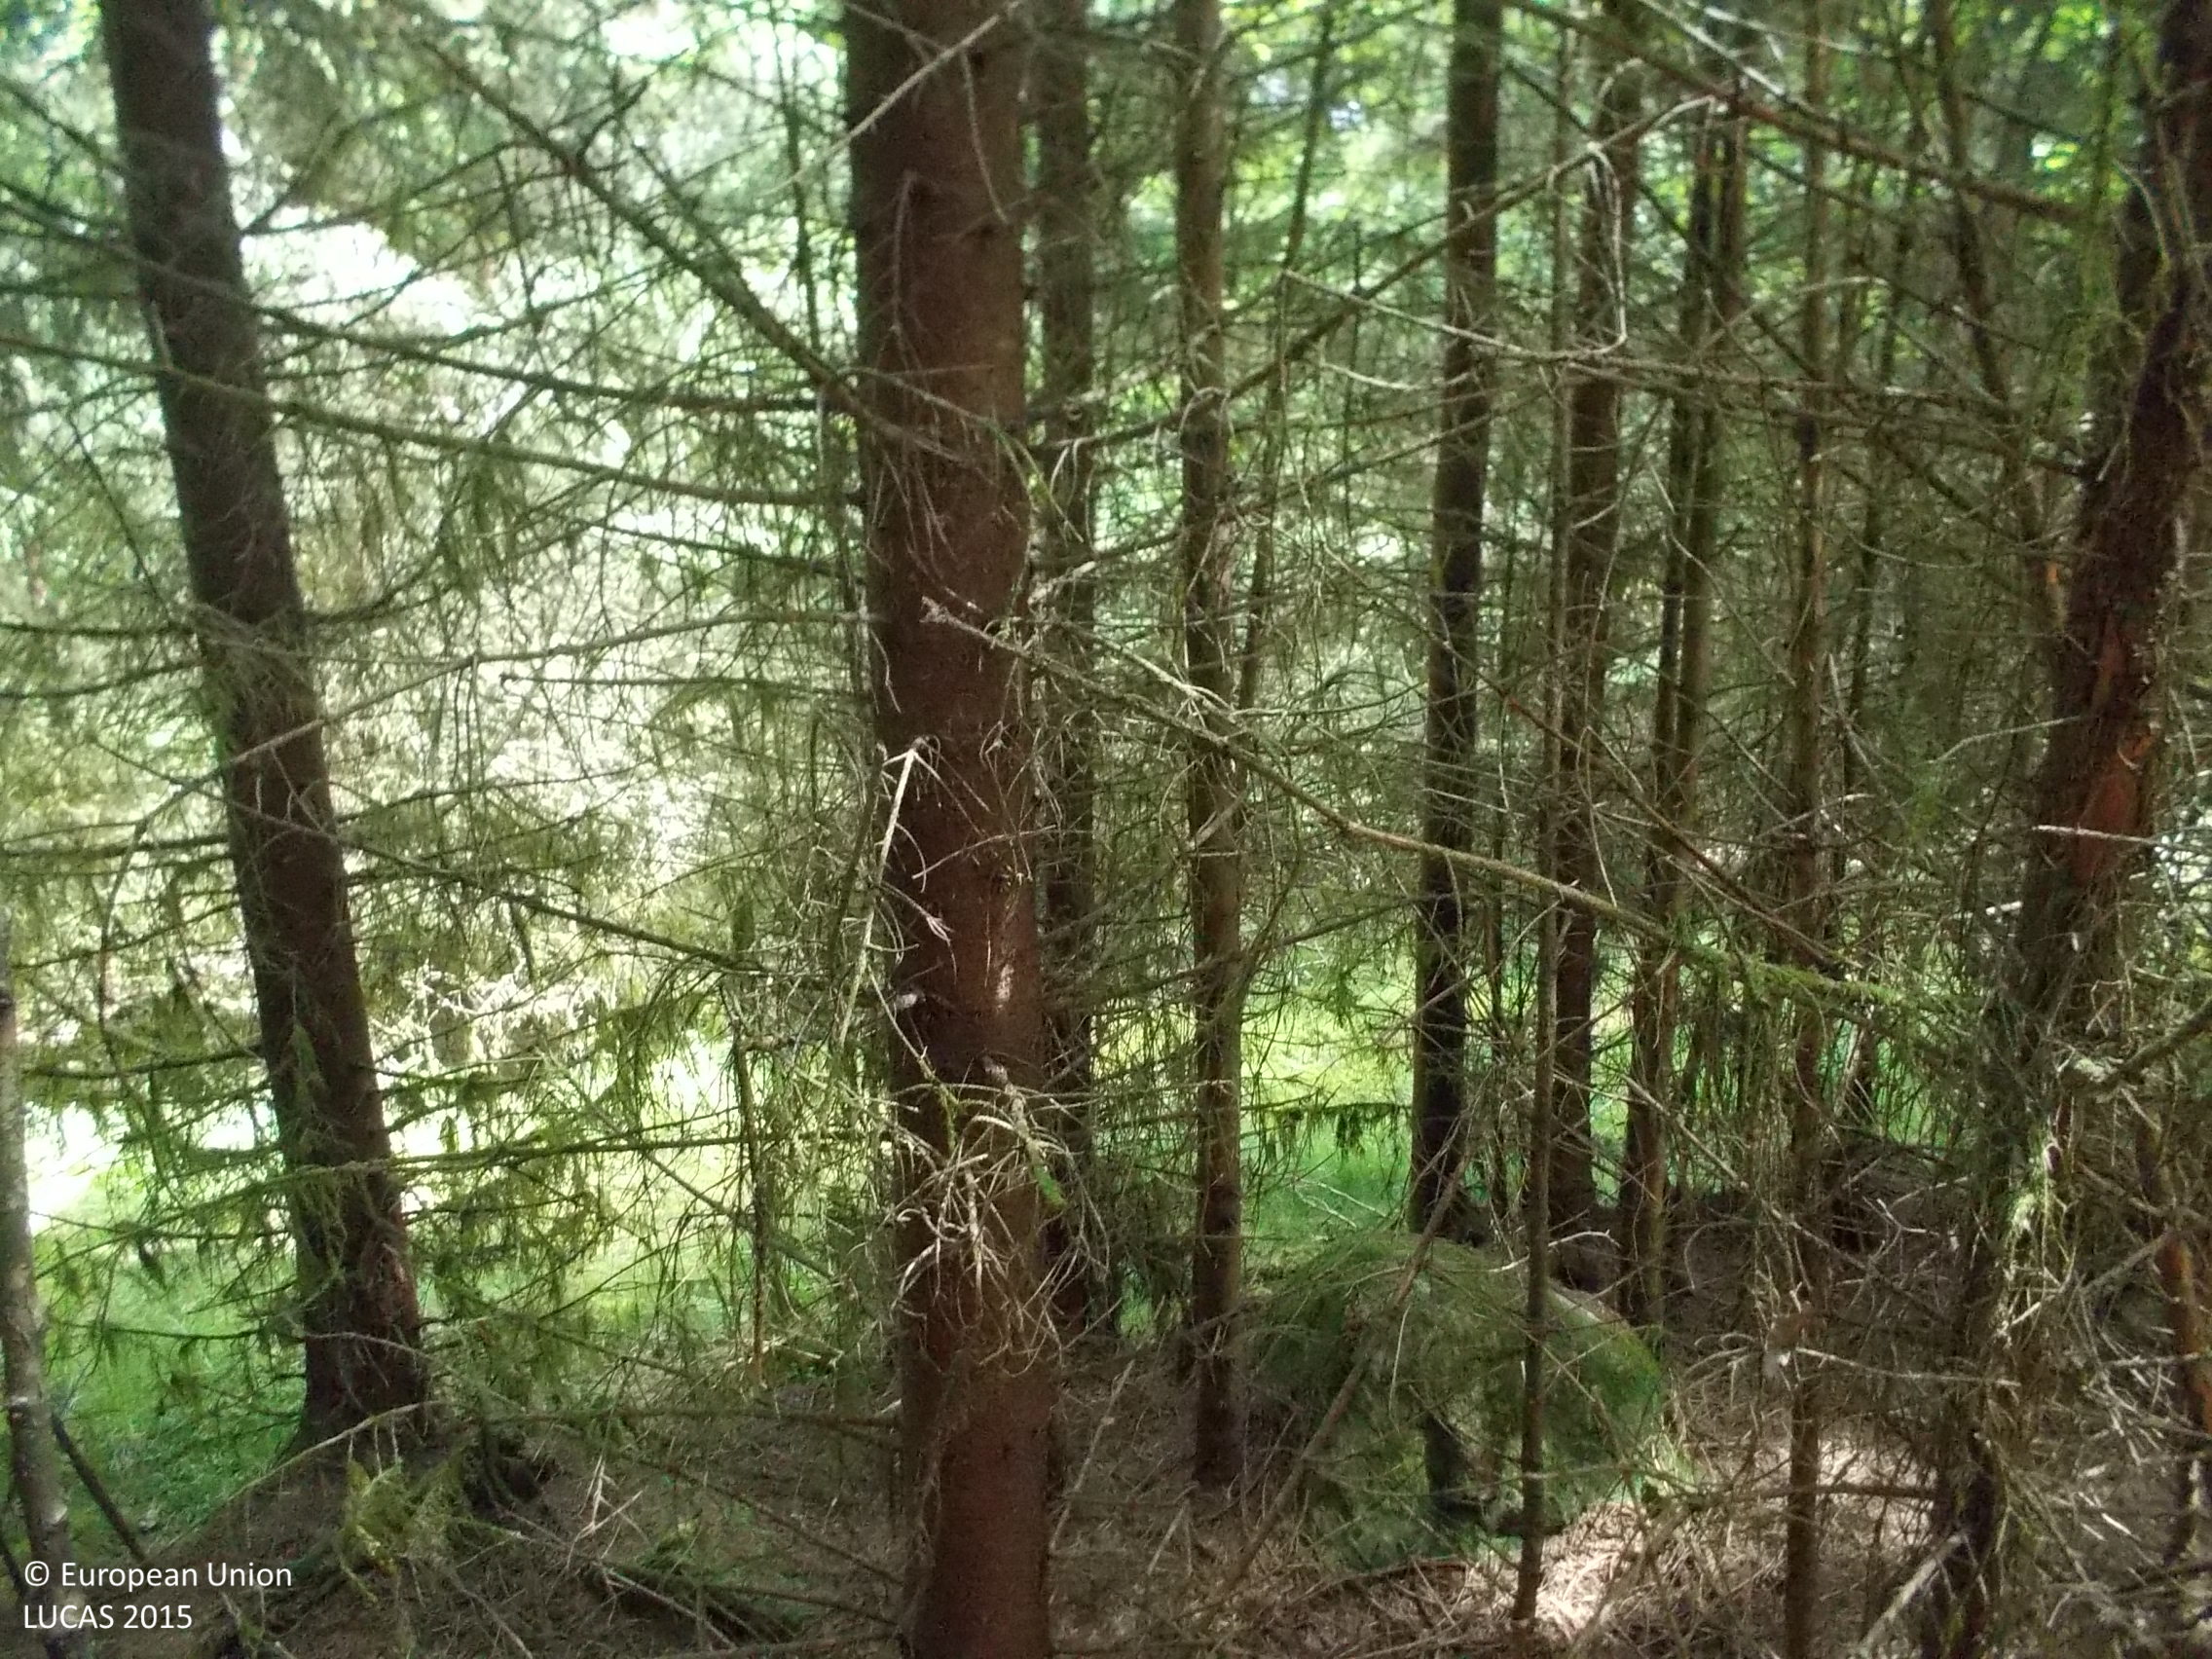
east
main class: Woodland
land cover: Spruce dominated coniferous woodland
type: boreal forest
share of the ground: > 75 %
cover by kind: coniferous forest trees 85 %, unconsolidated bare surface 10 %, lichens and mosses 5 %
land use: Forestry
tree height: > 5 m
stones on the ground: < 10 %
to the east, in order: Spruce dominated coniferous woodland; Tracks; Spruce dominated mixed woodland; Pine dominated mixed woodland; Ditches and canals; Pine dominated mixed woodland; Ditches and canals; Pine dominated mixed woodland
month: June
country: SE
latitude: 57.2870
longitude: 12.9658
